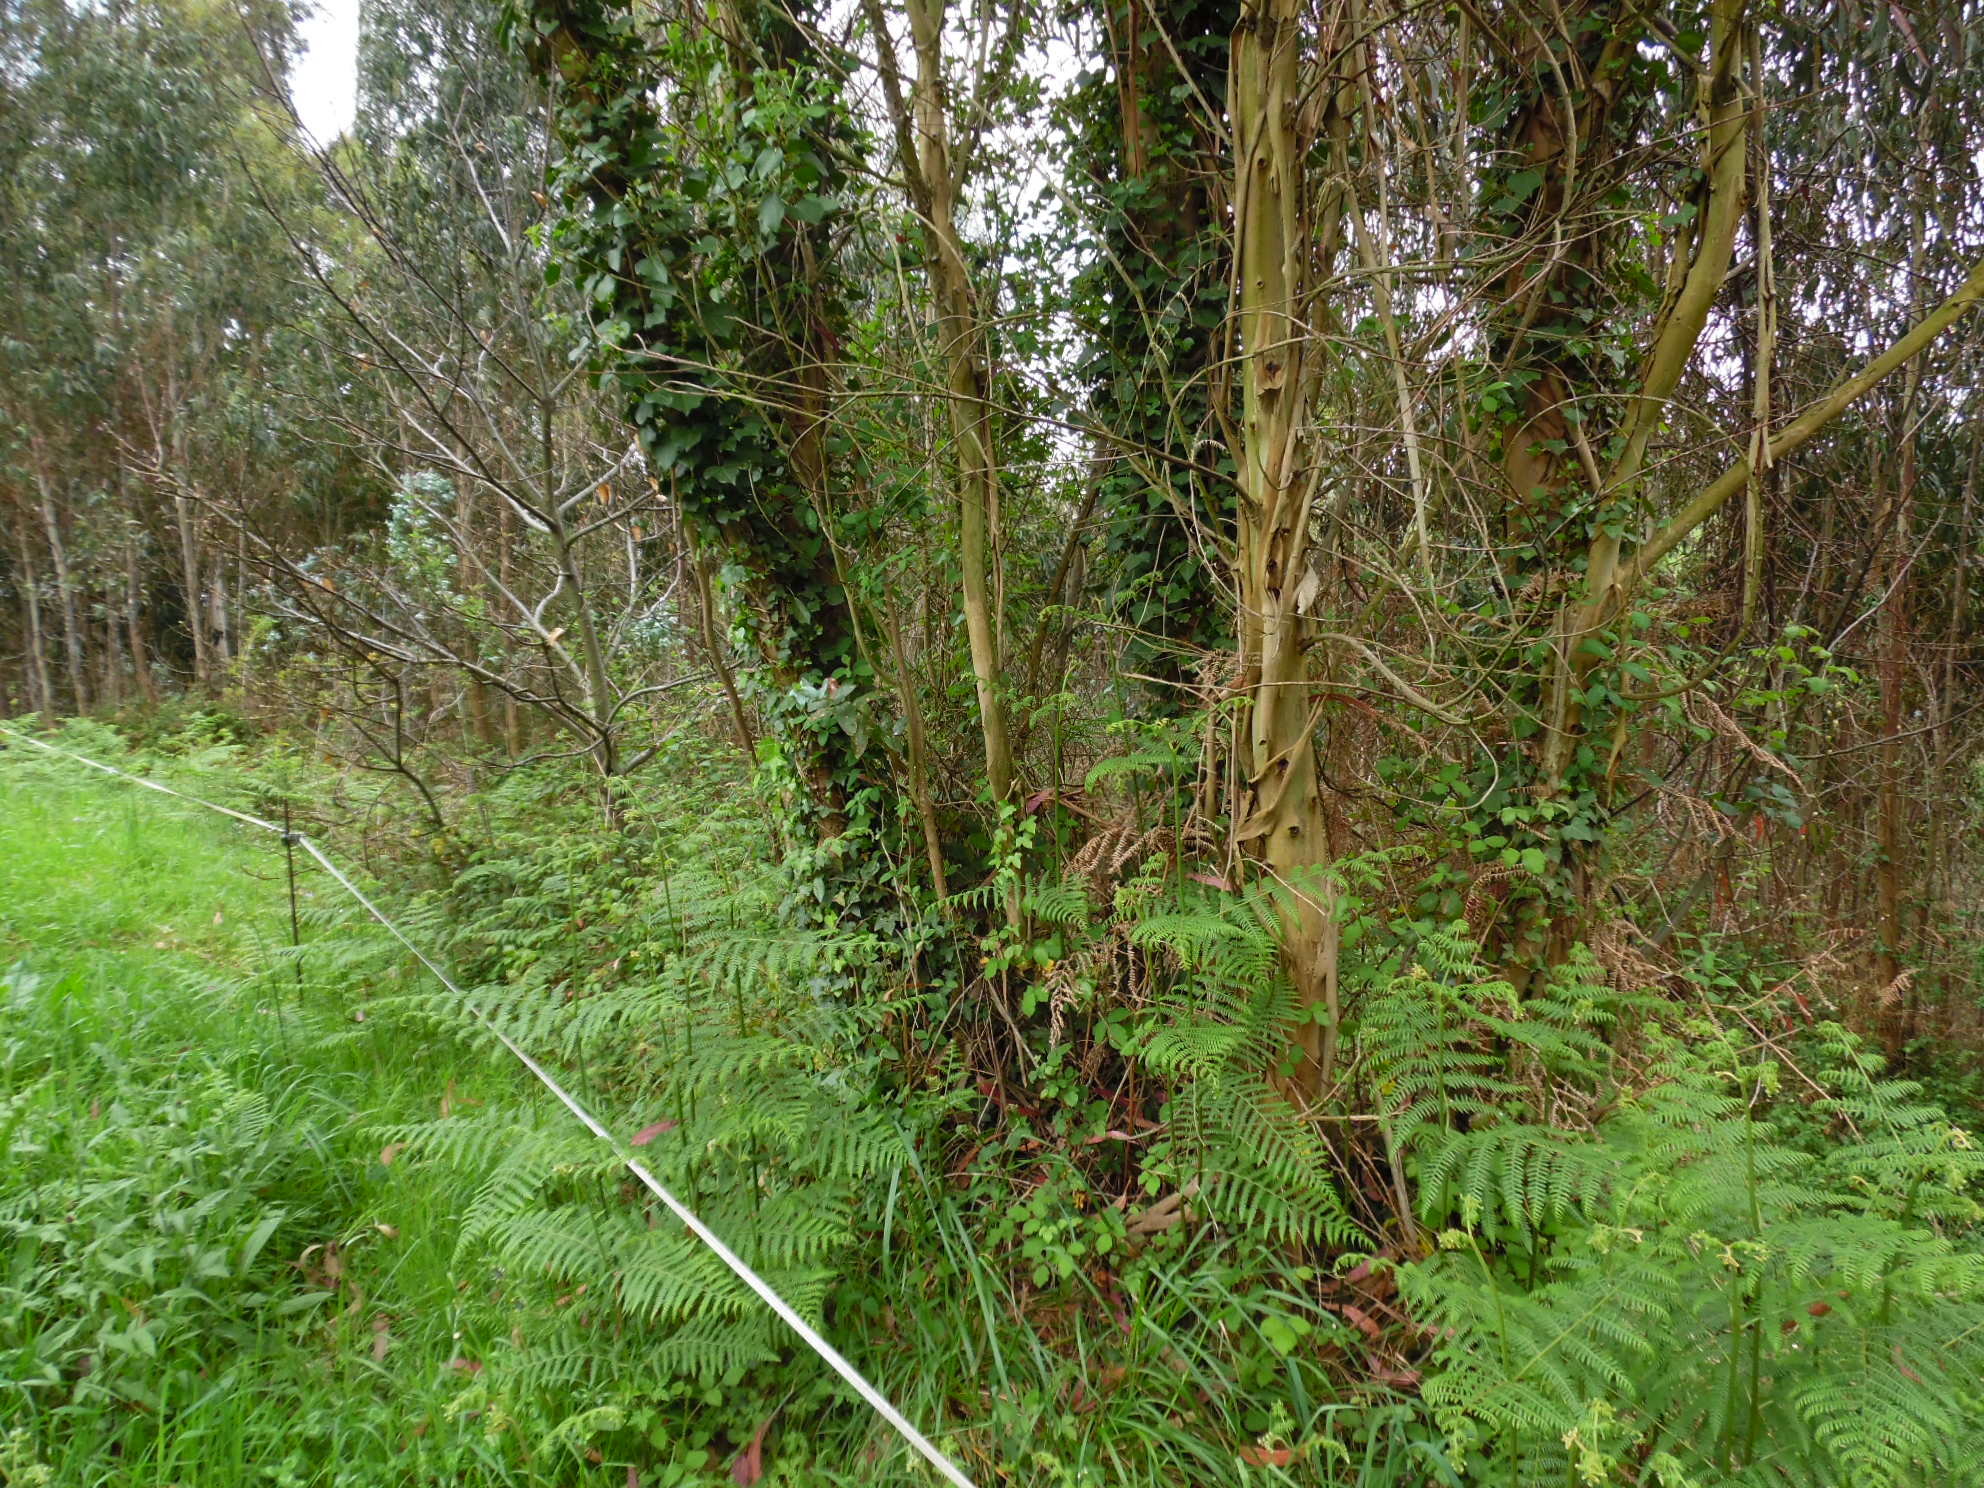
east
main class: Grassland
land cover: Grassland without tree/shrub cover
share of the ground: > 75 %
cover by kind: herbaceous plants 100 %
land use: Agriculture (excluding fallow land and kitchen gardens)
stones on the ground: 10 - 25 %
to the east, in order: Grassland without tree/shrub cover; Tracks; Broadleaved woodland; Other bare soil; Electric lines; Other bare soil; Broadleaved woodland; Paved roads, cycling and walking lanes; Broadleaved woodland; Grassland without tree/shrub cover; Rivers and streams; Groves; Grassland without tree/shrub cover; Electric lines; Grassland without tree/shrub cover; Fences; Grass margins; Paved roads, cycling and walking lanes; Grass margins; Groves; Spontaneously vegetated surfaces
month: April
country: ES
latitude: 43.5031
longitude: -5.8842
